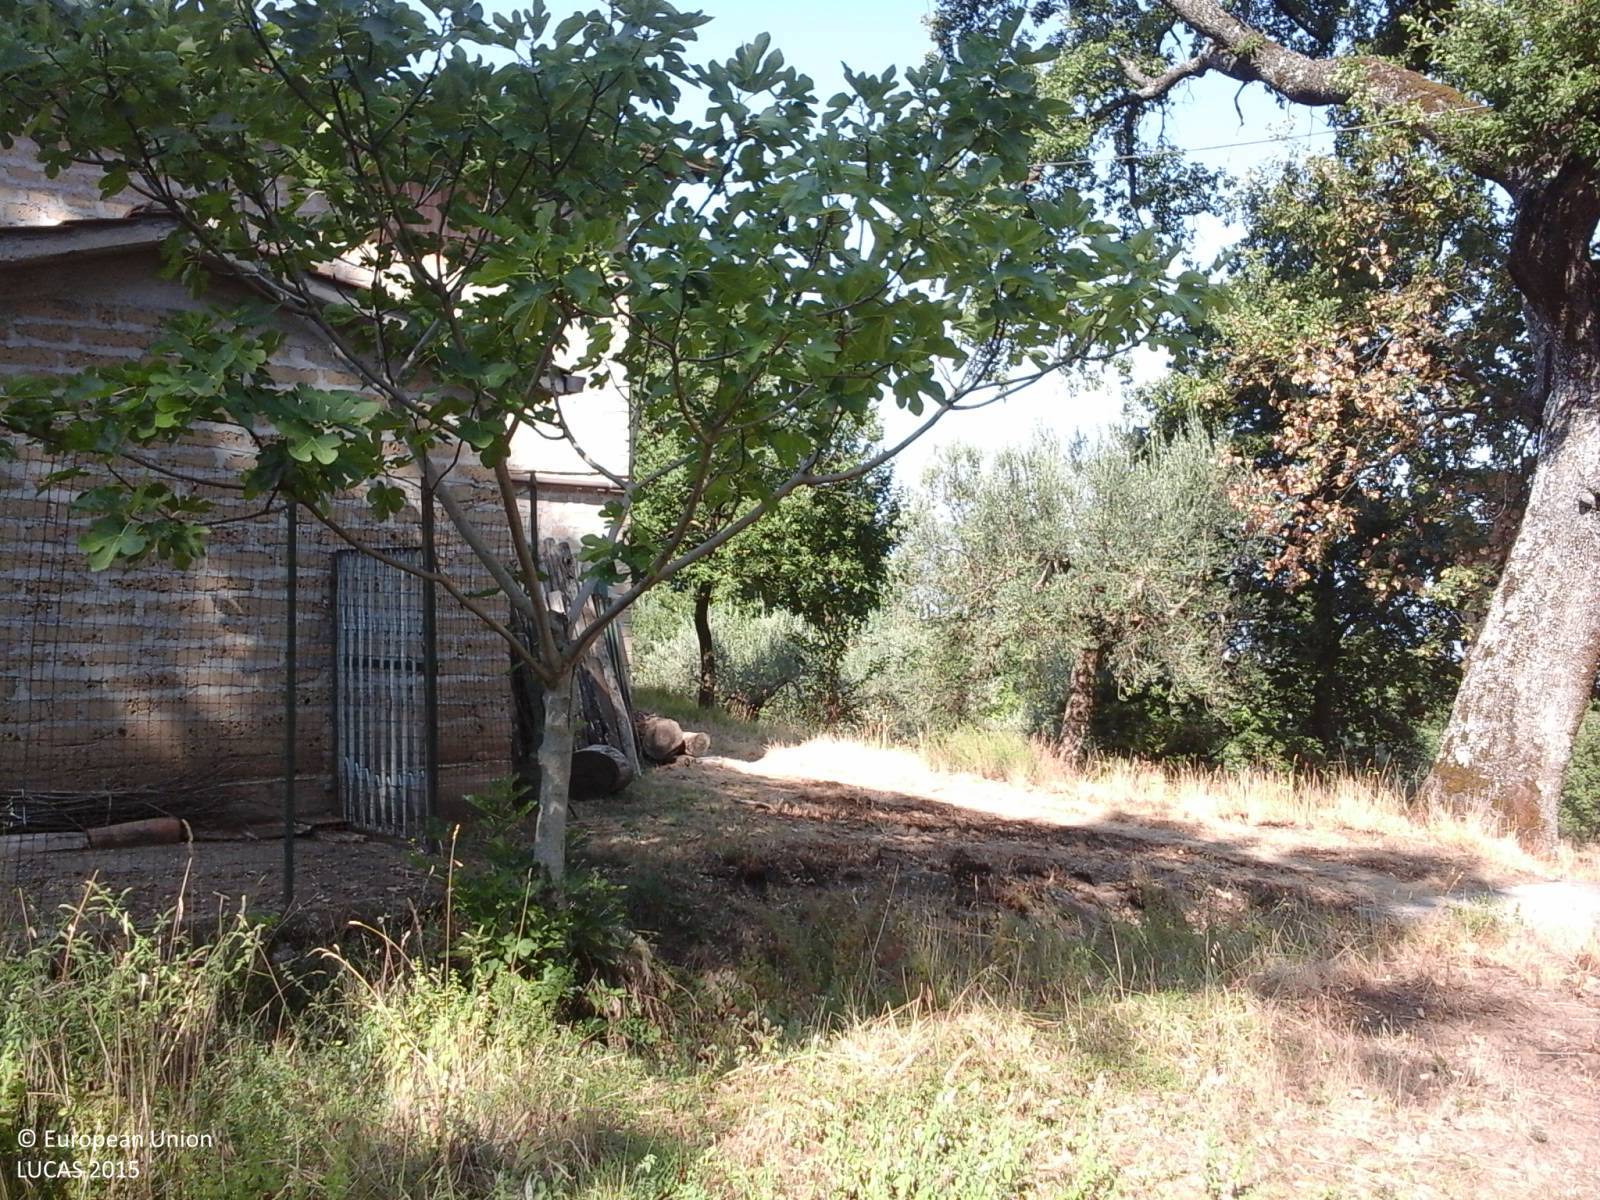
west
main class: Grassland
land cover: Spontaneously vegetated surfaces
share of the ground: > 75 %
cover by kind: herbaceous plants 100 %
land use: Fallow land
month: August
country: IT
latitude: 41.3292
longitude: 13.9396
